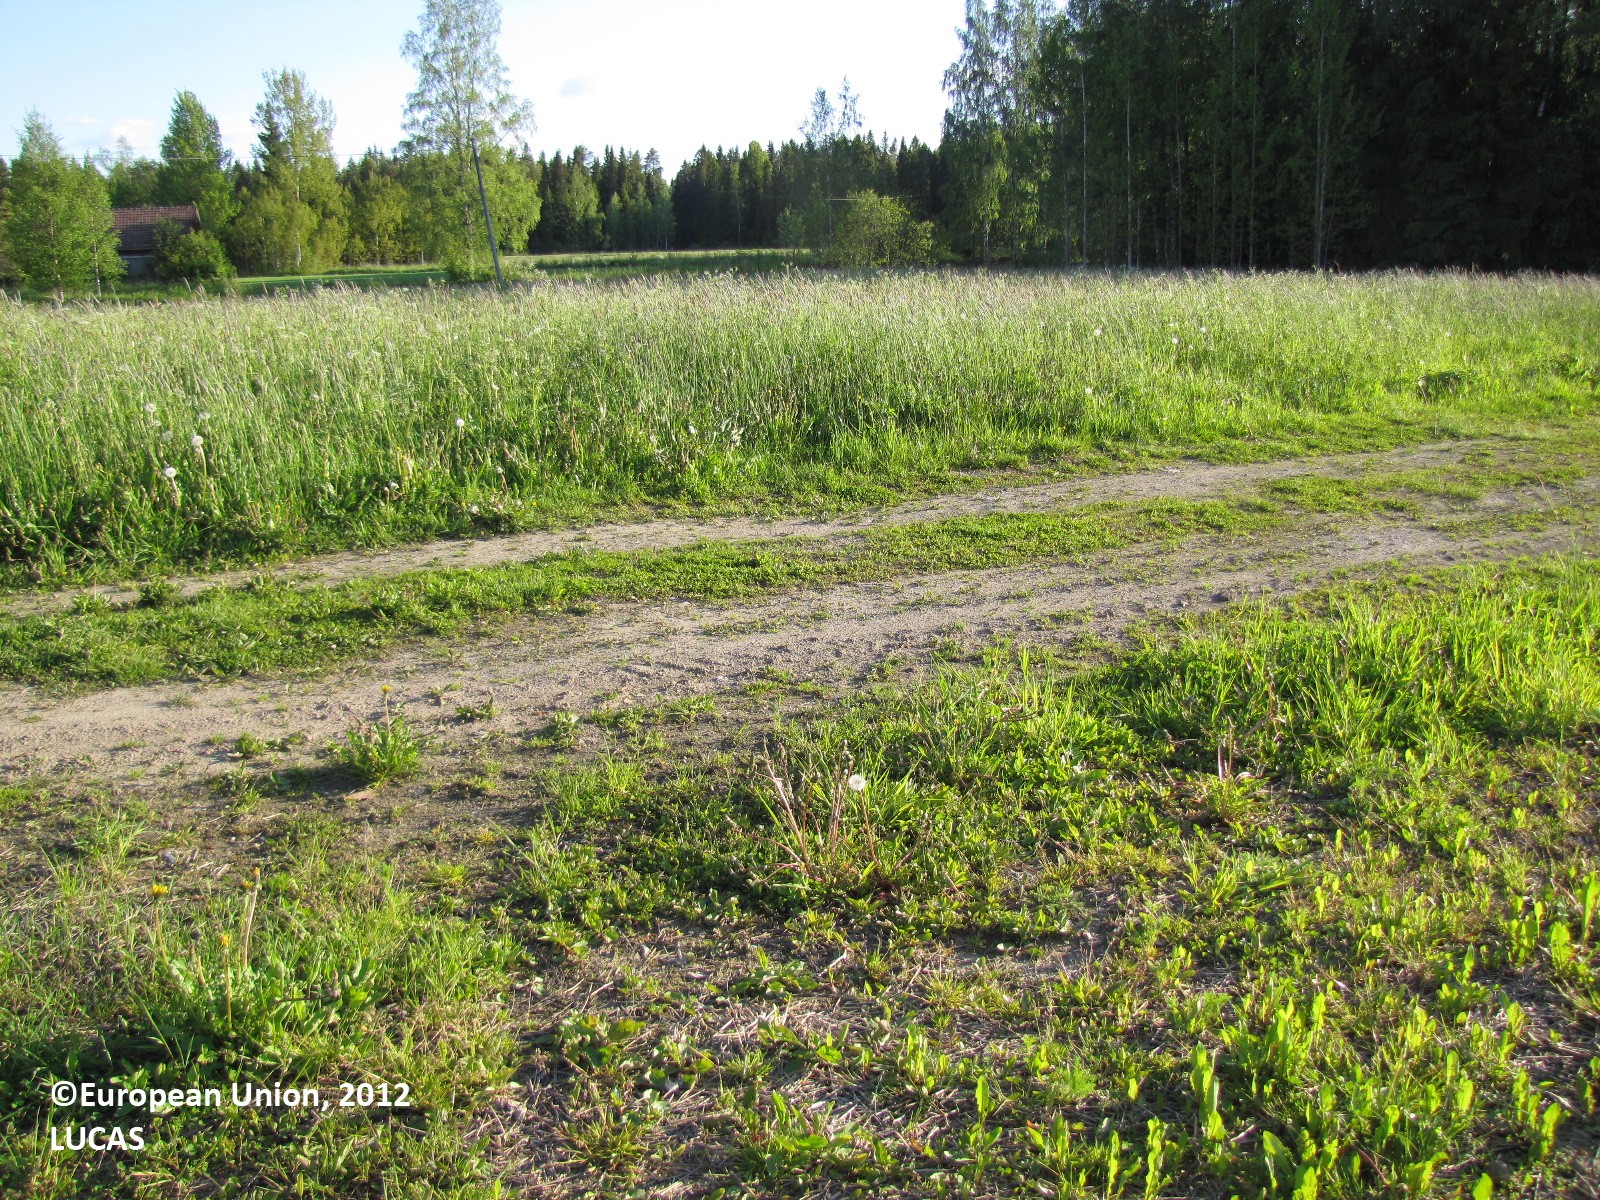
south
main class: Cropland
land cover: Common wheat
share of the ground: 25 - 50 %
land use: Agriculture (excluding fallow land and kitchen gardens)
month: June
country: FI
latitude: 61.2095
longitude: 22.9340
